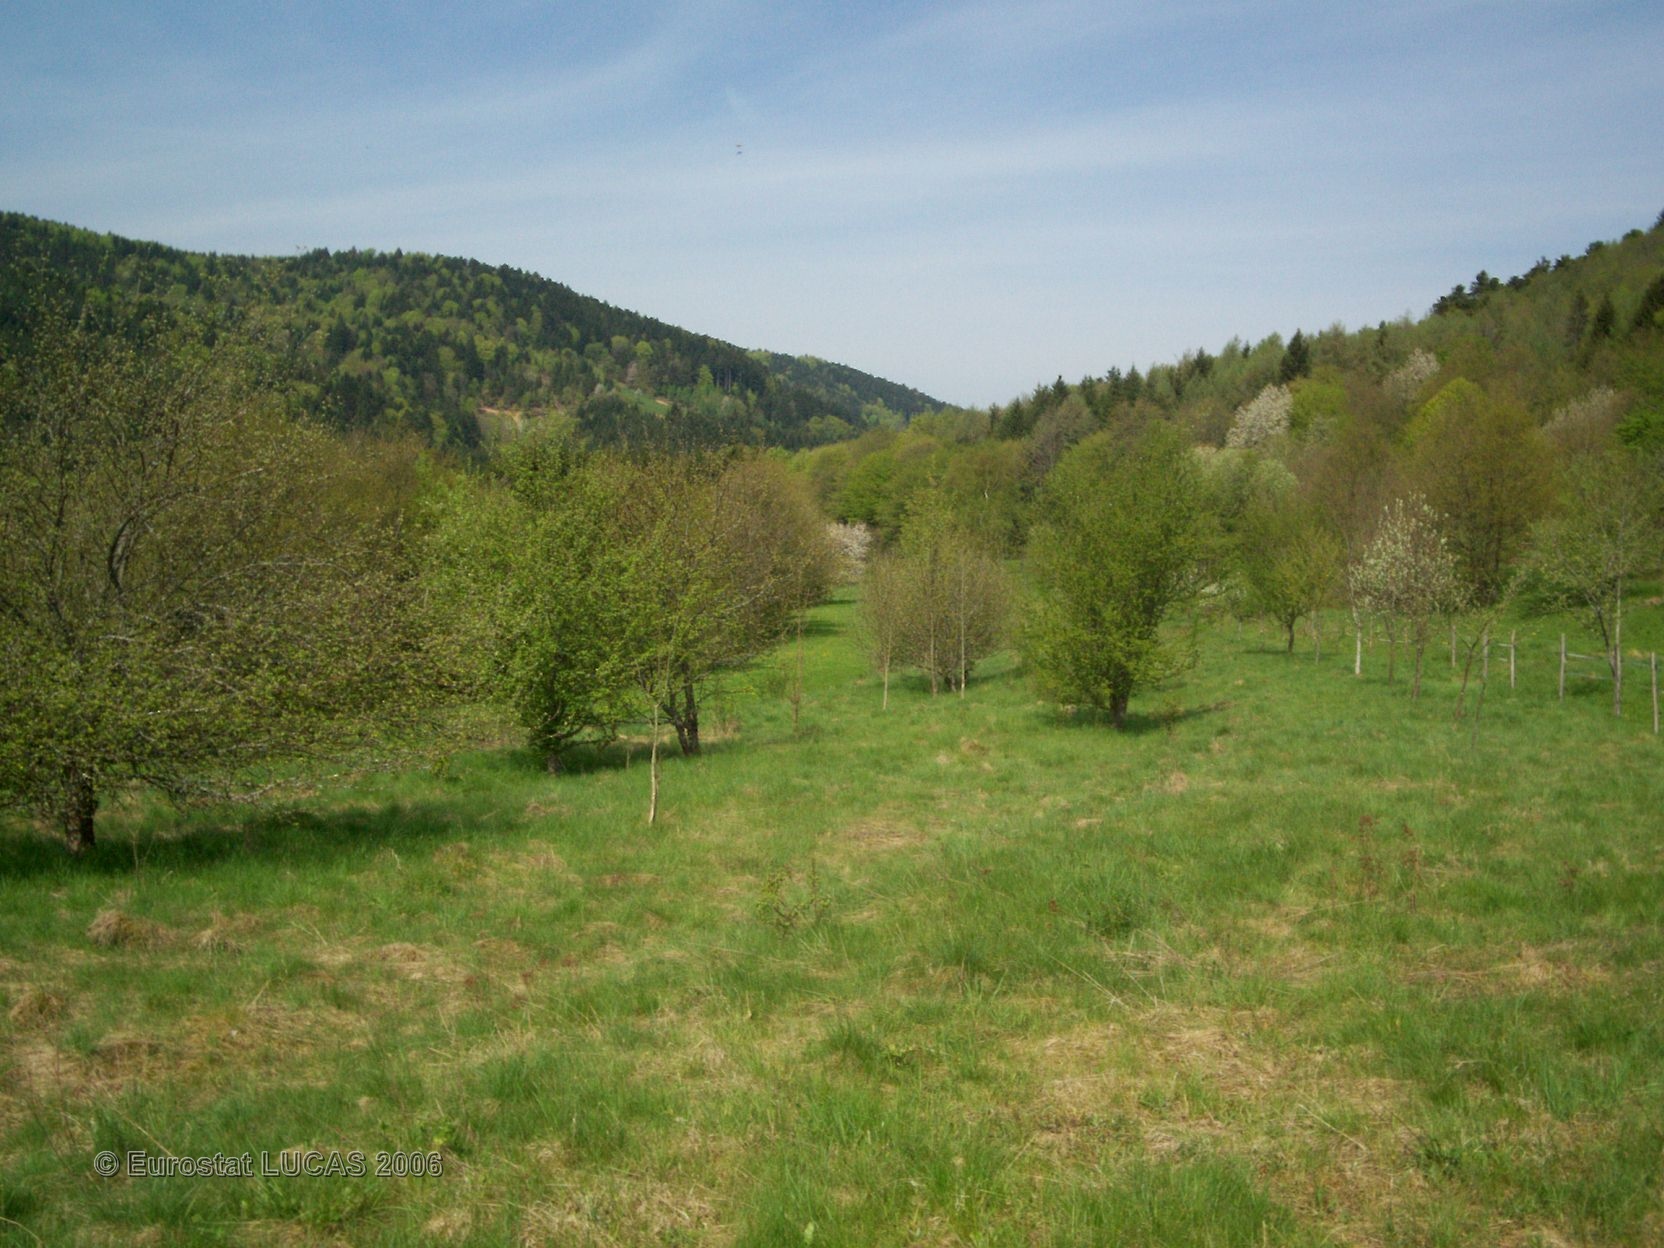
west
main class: Grassland
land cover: Grassland with sparse tree/shrub cover
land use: Agriculture (excluding fallow land and kitchen gardens)
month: May
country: FR
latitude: 47.7858
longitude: 6.9715
